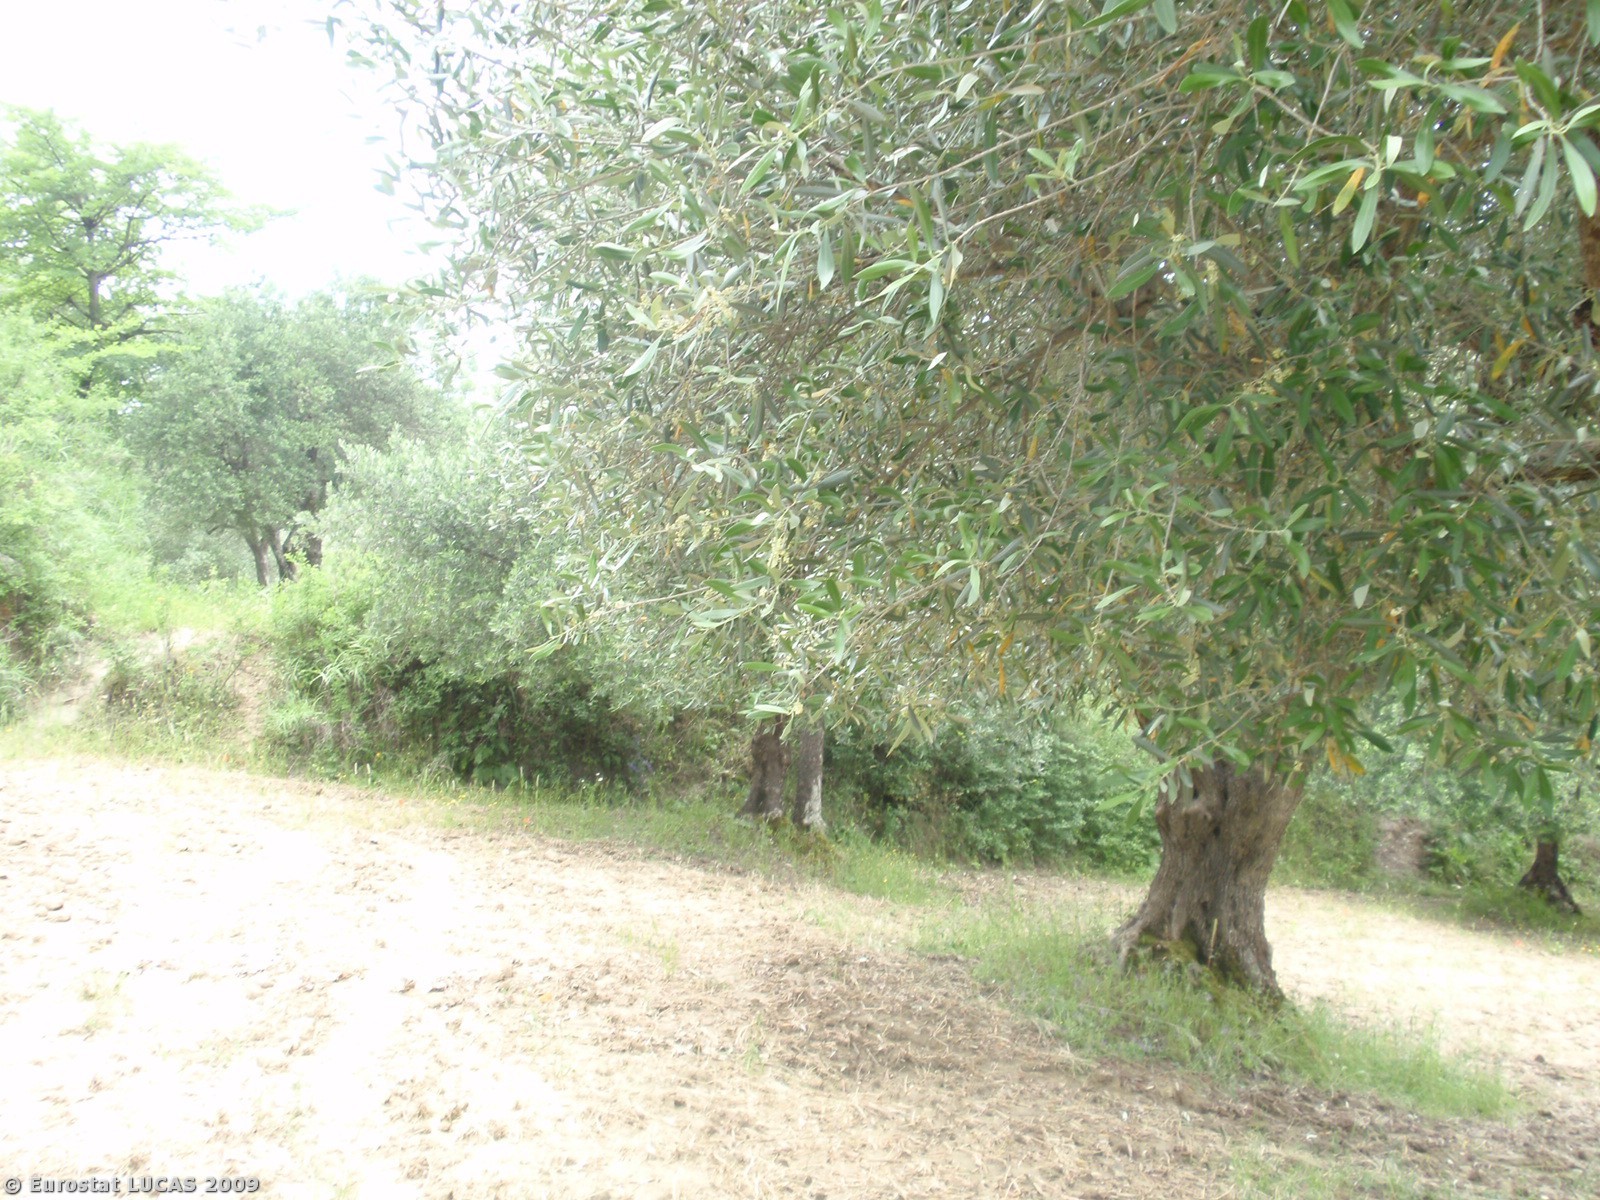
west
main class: Cropland
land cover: Olive groves
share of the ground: 50 - 75 %
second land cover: Bare land
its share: 50 - 75 %
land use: Agriculture (excluding fallow land and kitchen gardens)
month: May
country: IT
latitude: 40.2485
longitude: 16.2643
